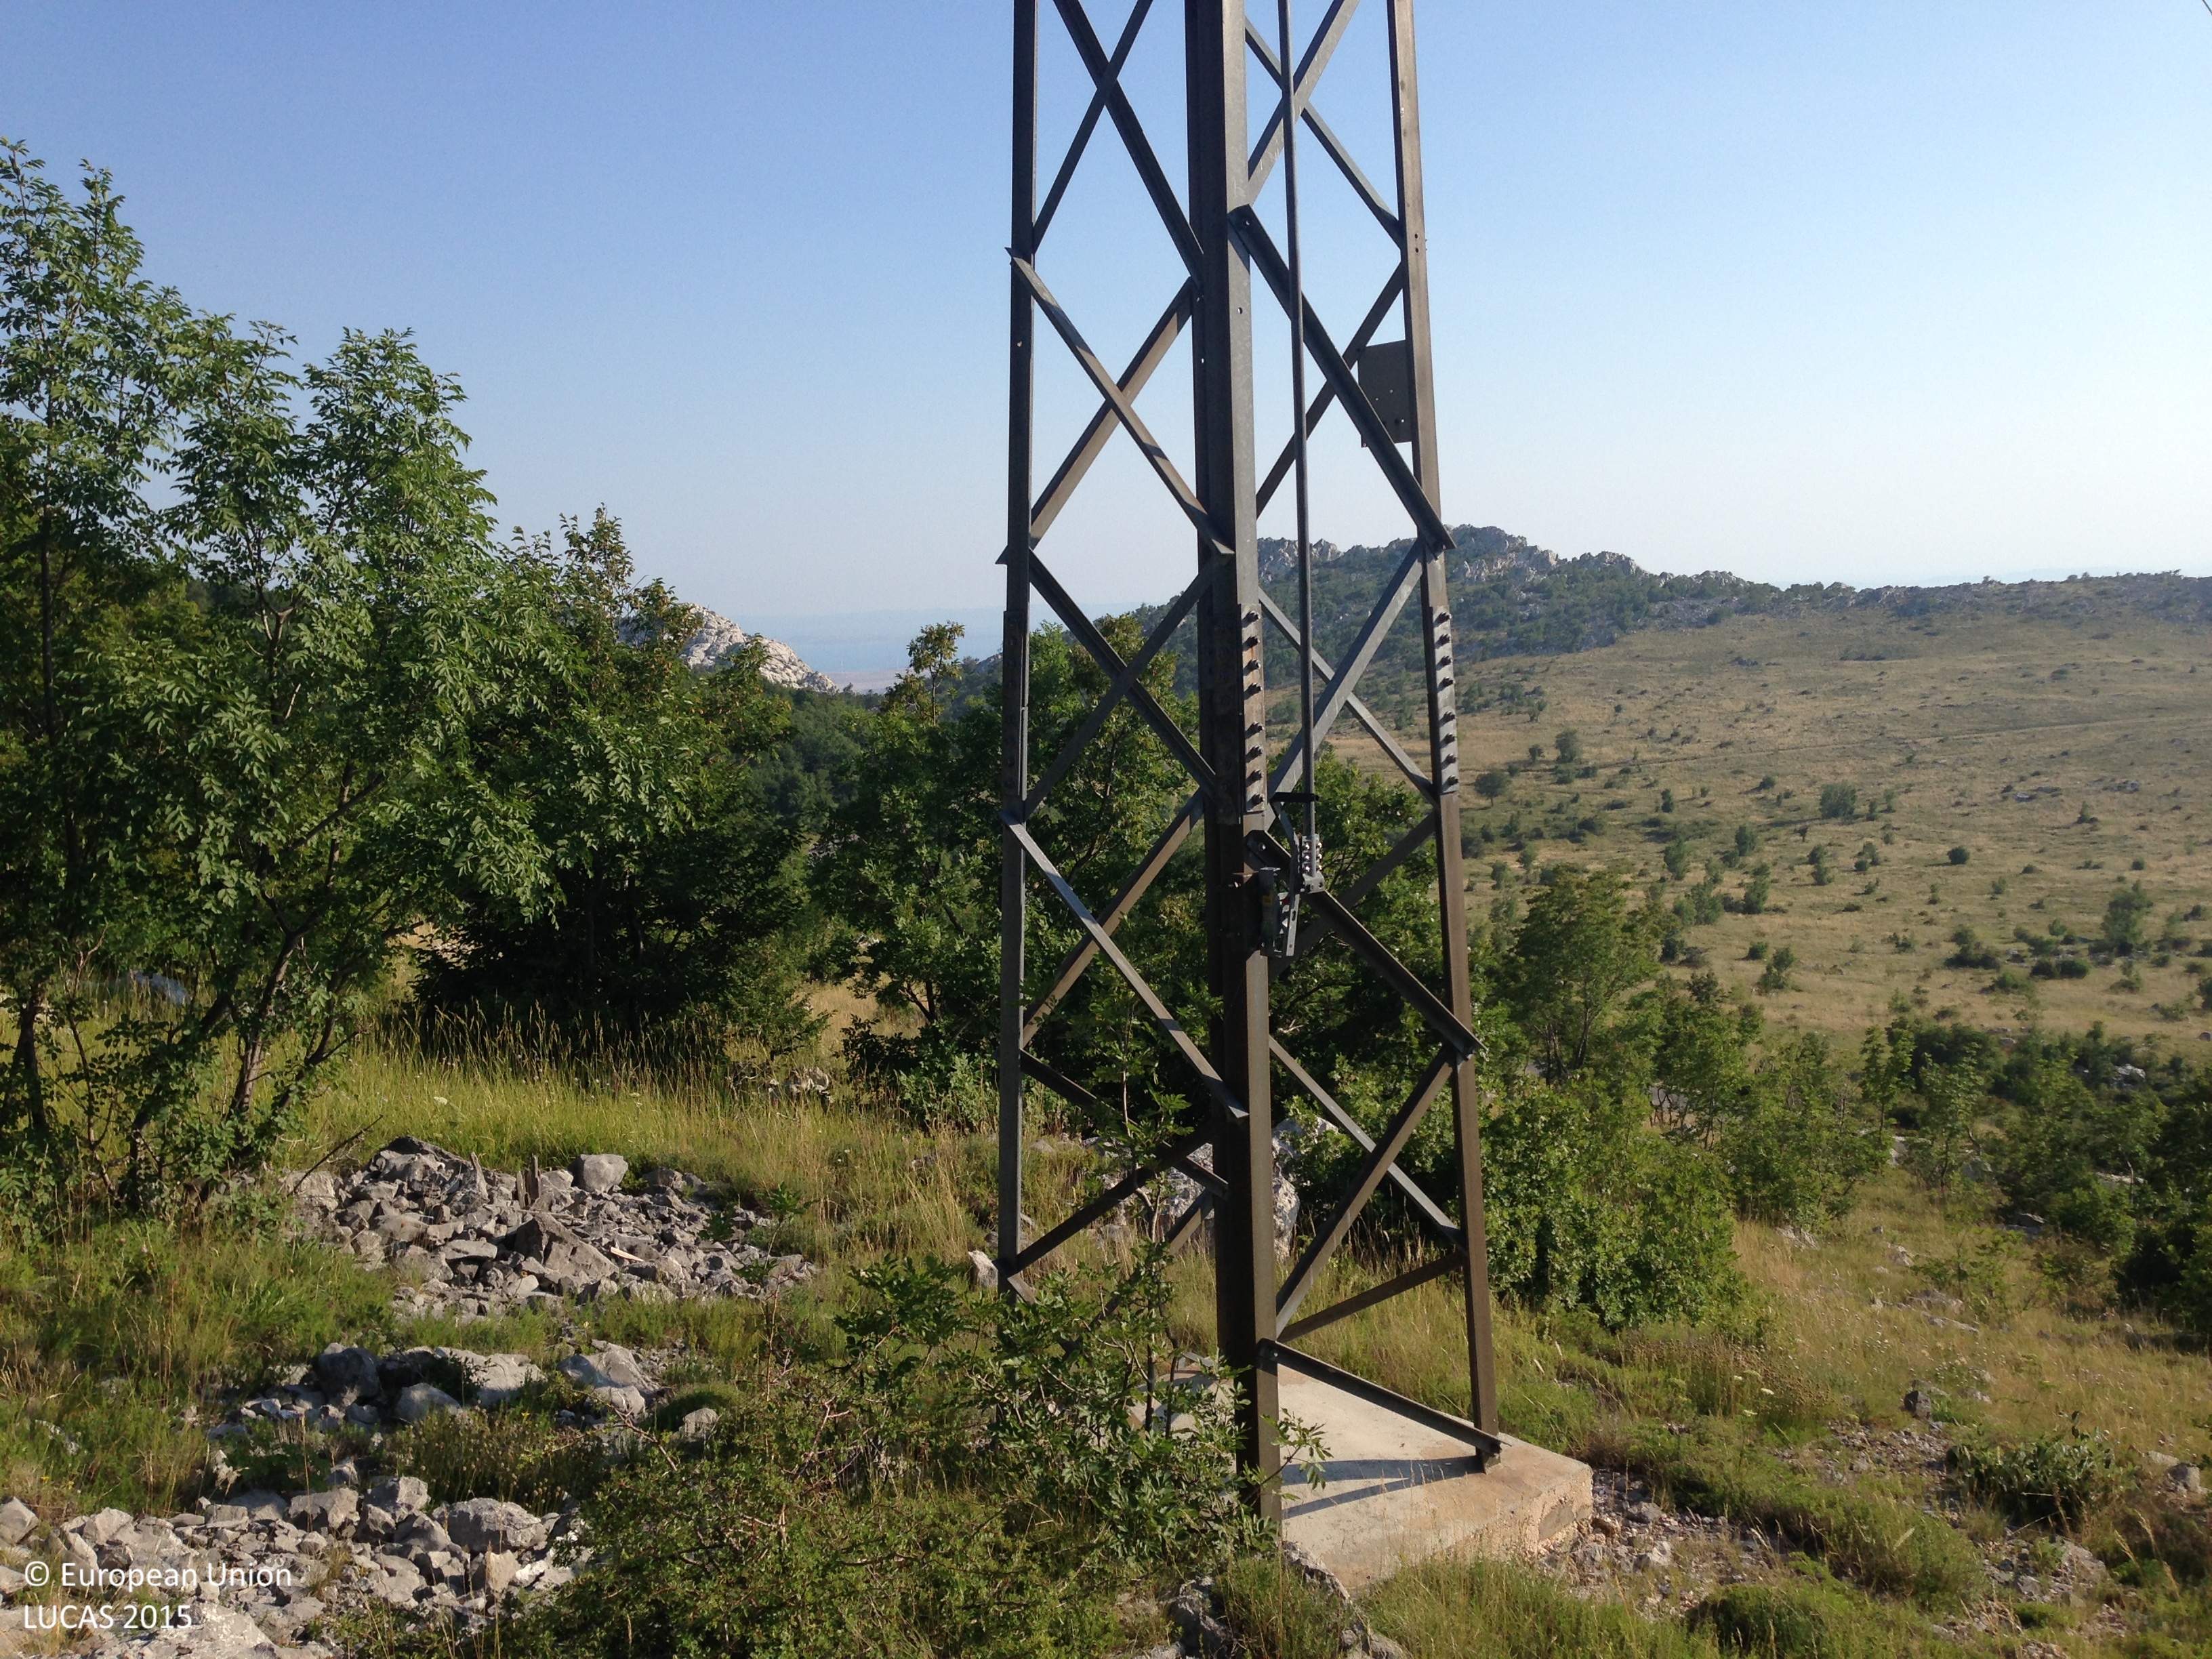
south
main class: Woodland
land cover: Broadleaved woodland
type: thermophilous deciduous forest
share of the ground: > 75 %
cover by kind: broadleaved forest trees 35 %, herbaceous plants 30 %, consolidated bare surface 15 %, shrubs 10 %, unconsolidated bare surface 10 %
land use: Forestry
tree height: < 5 m
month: July
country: HR
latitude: 44.5316
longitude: 15.1148
